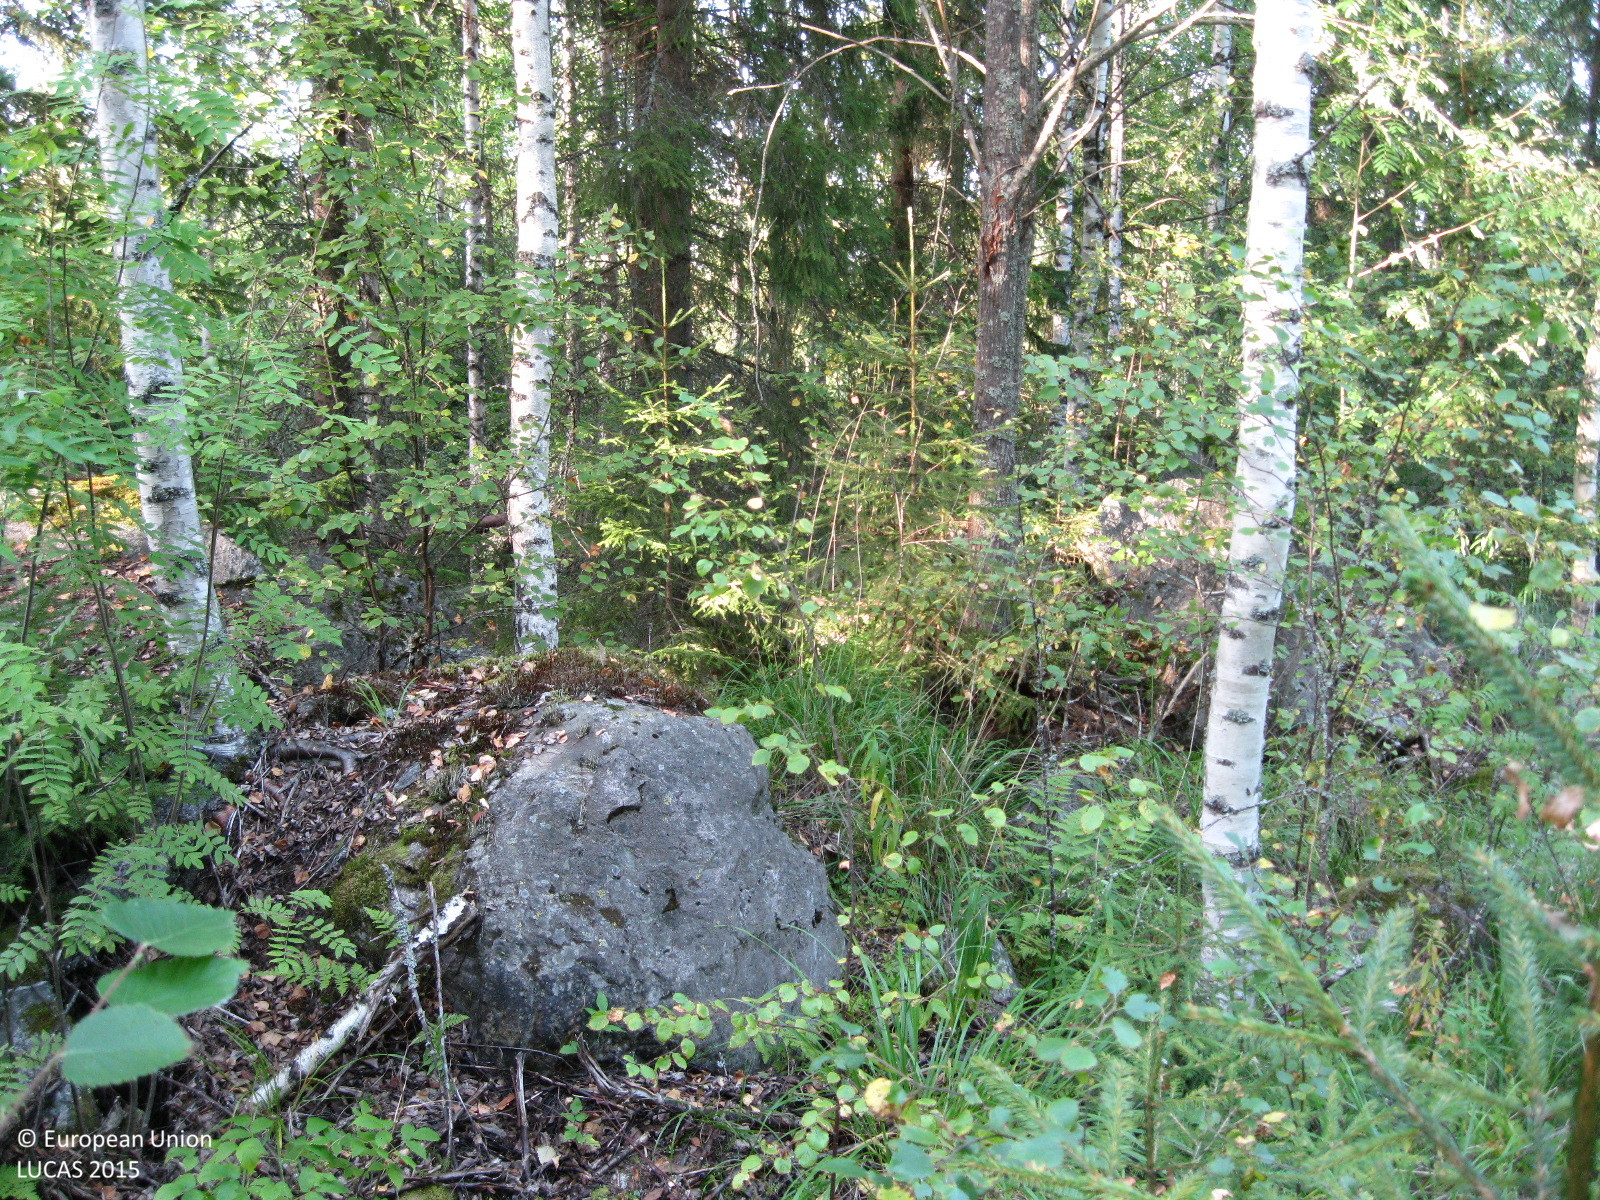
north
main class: Woodland
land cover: Spruce dominated mixed woodland
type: boreal forest
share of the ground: 50 - 75 %
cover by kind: coniferous forest trees 50 %, herbaceous plants 30 %, broadleaved forest trees 20 %
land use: Forestry
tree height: > 5 m
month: August
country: FI
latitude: 61.3796
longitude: 25.1414
